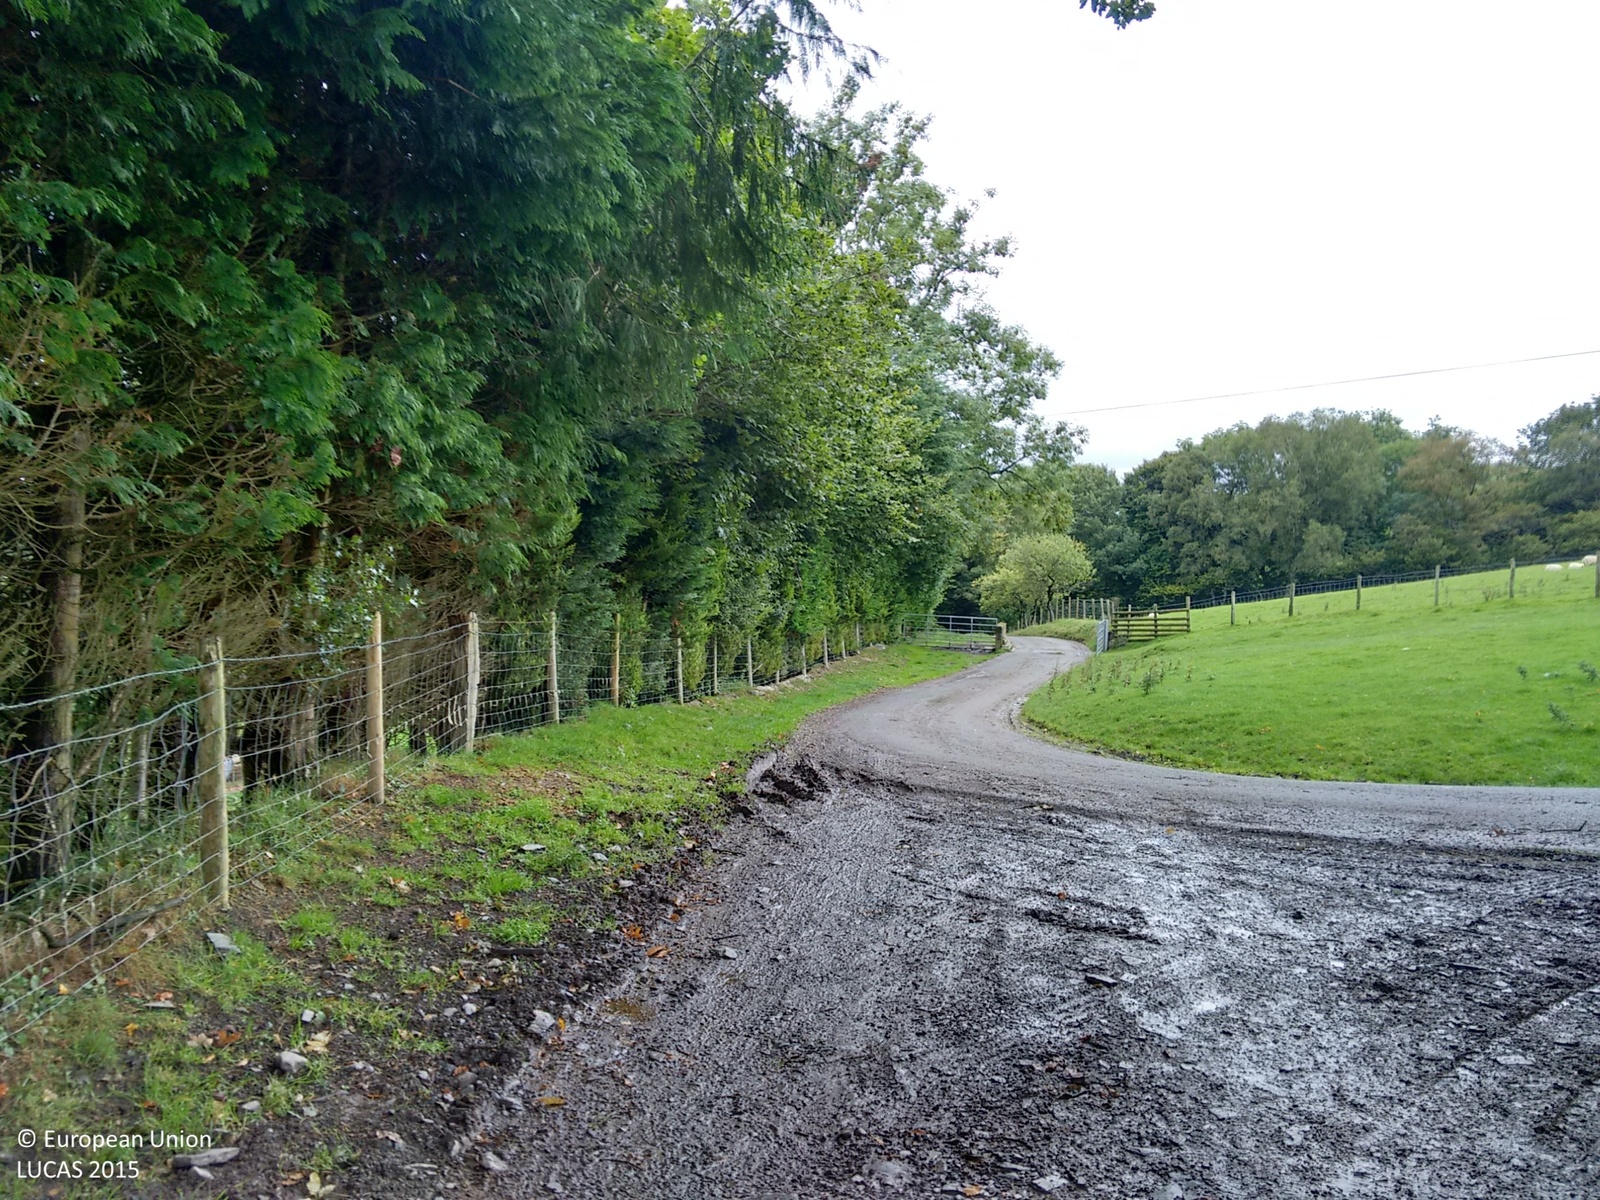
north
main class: Woodland
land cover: Broadleaved woodland
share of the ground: > 75 %
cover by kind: broadleaved forest trees 60 %, herbaceous plants 40 %
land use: Agriculture (excluding fallow land and kitchen gardens)
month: September
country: GB
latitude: 52.2265
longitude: -3.9278
